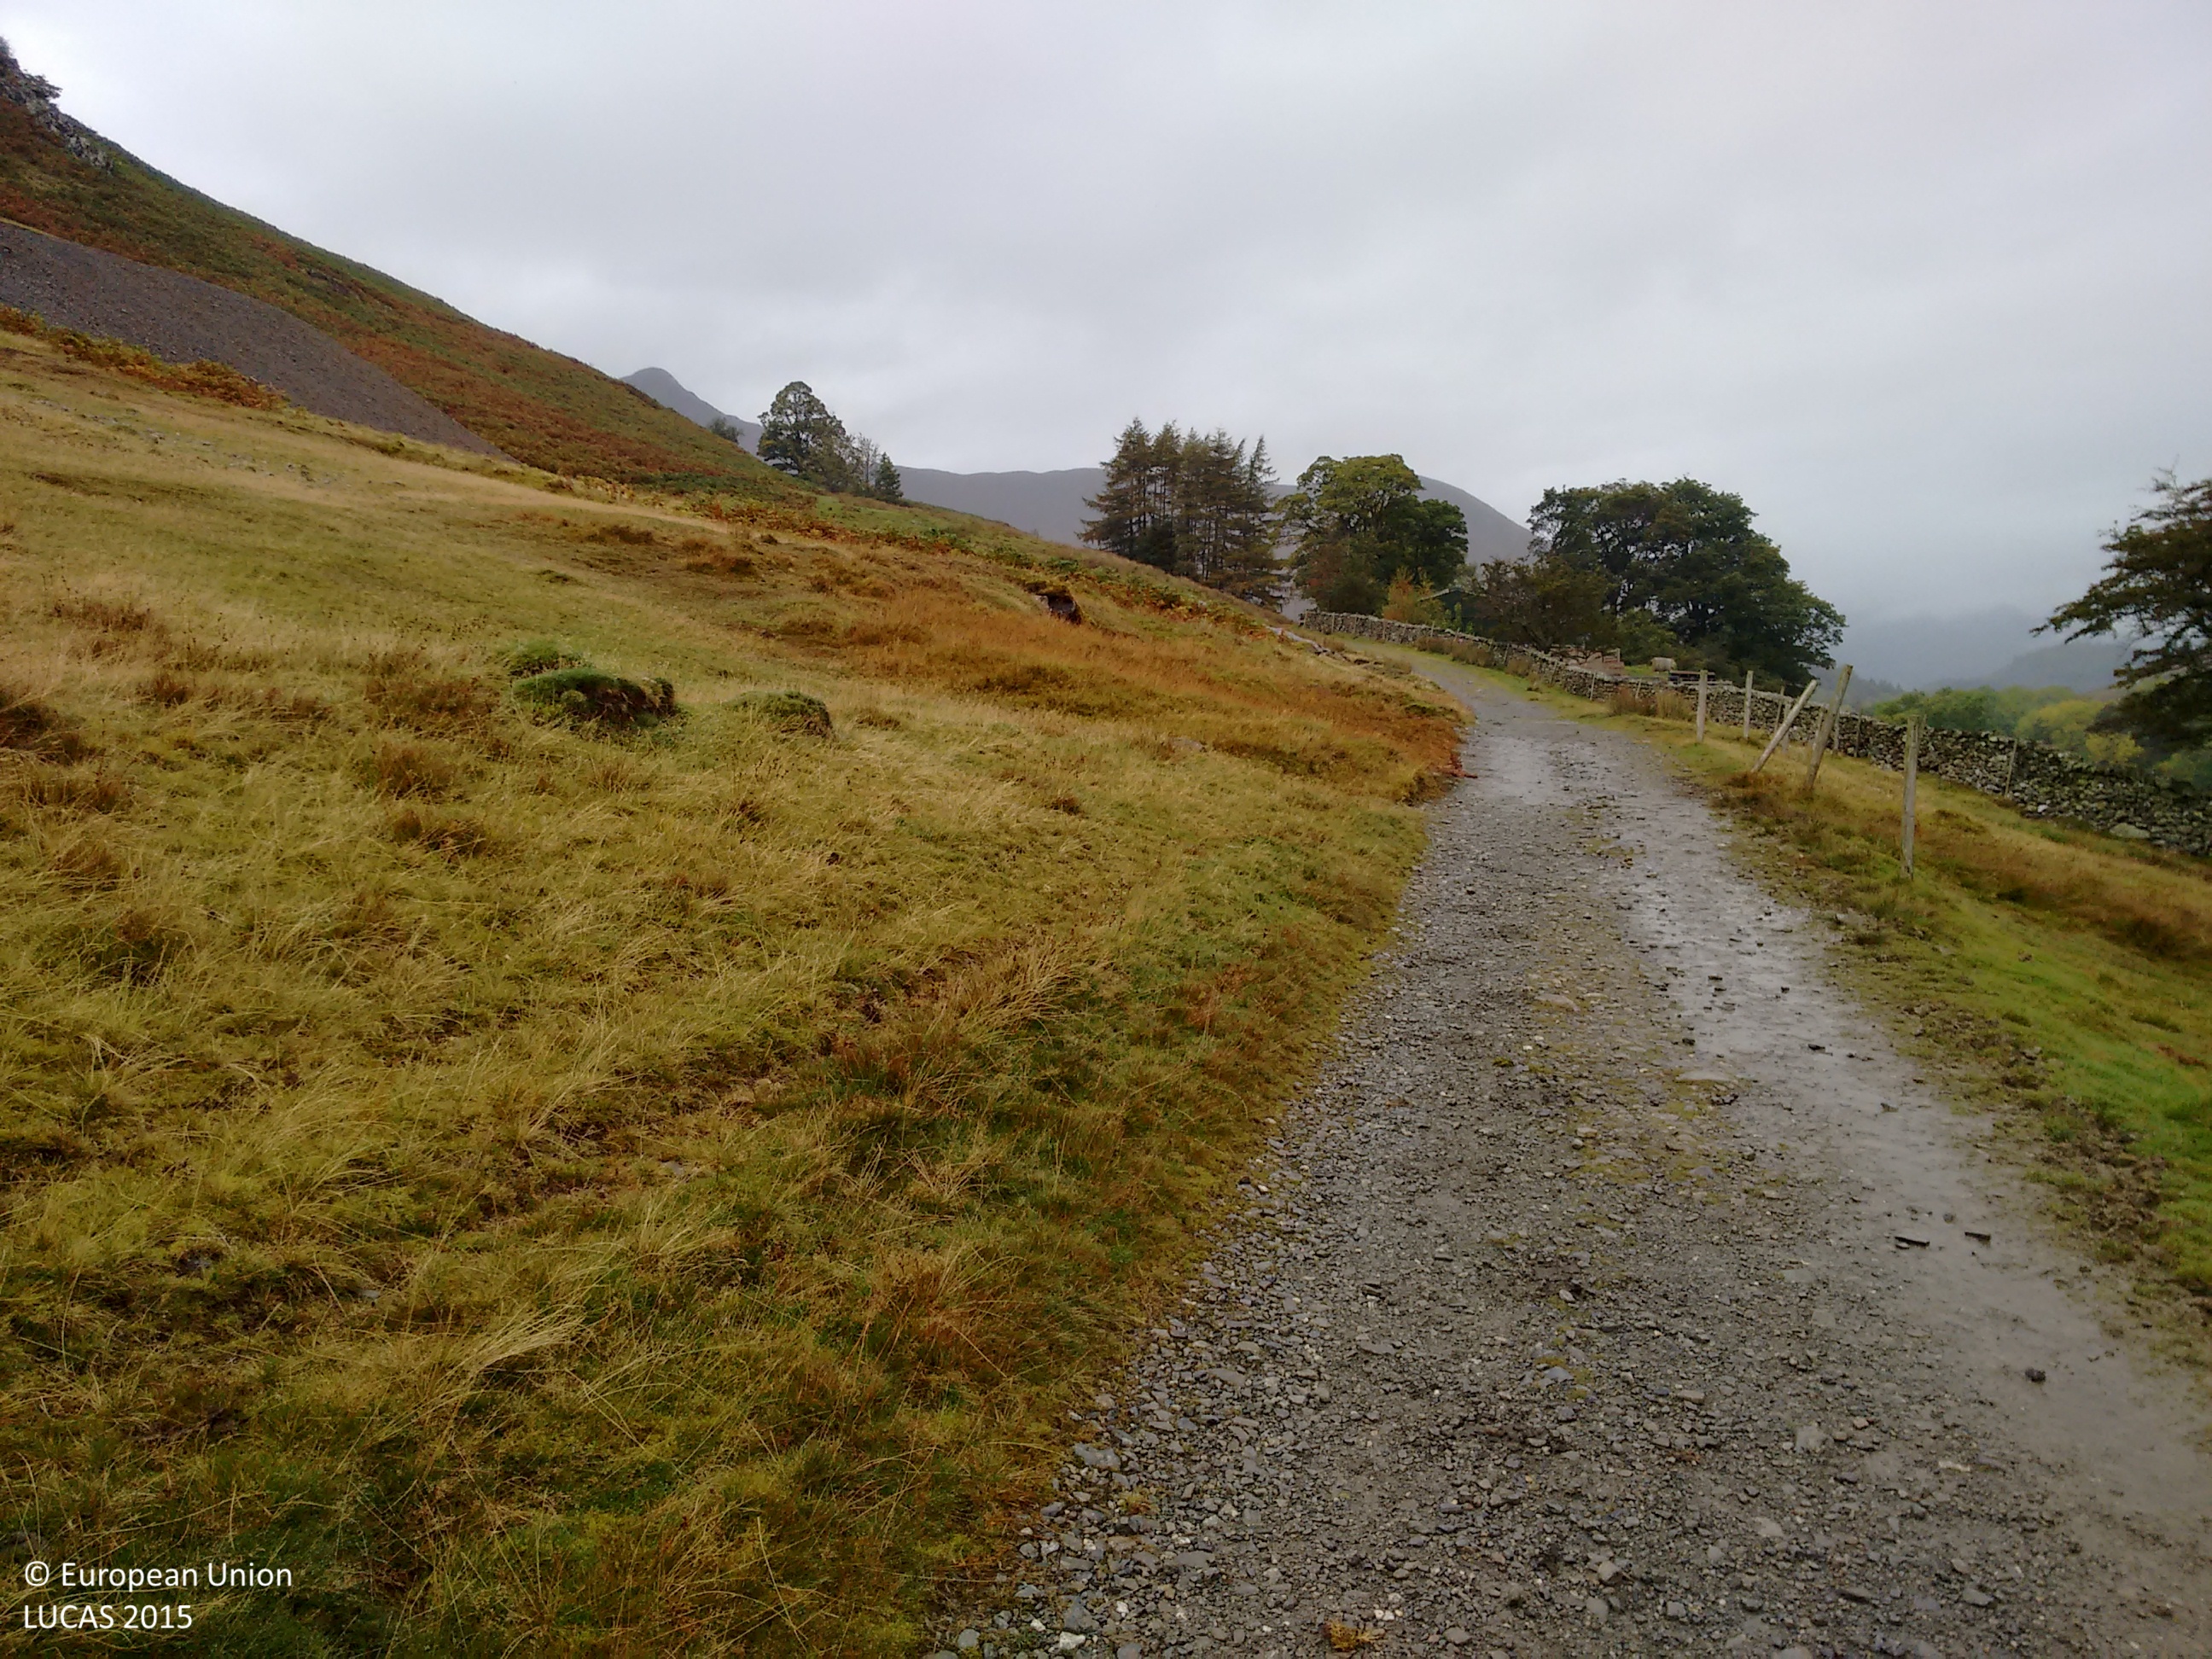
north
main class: Shrubland
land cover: Shrubland without tree cover
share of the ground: > 75 %
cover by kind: shrubs 100 %
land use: Agriculture (excluding fallow land and kitchen gardens)
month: October
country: GB
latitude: 54.5530
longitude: -3.2028
